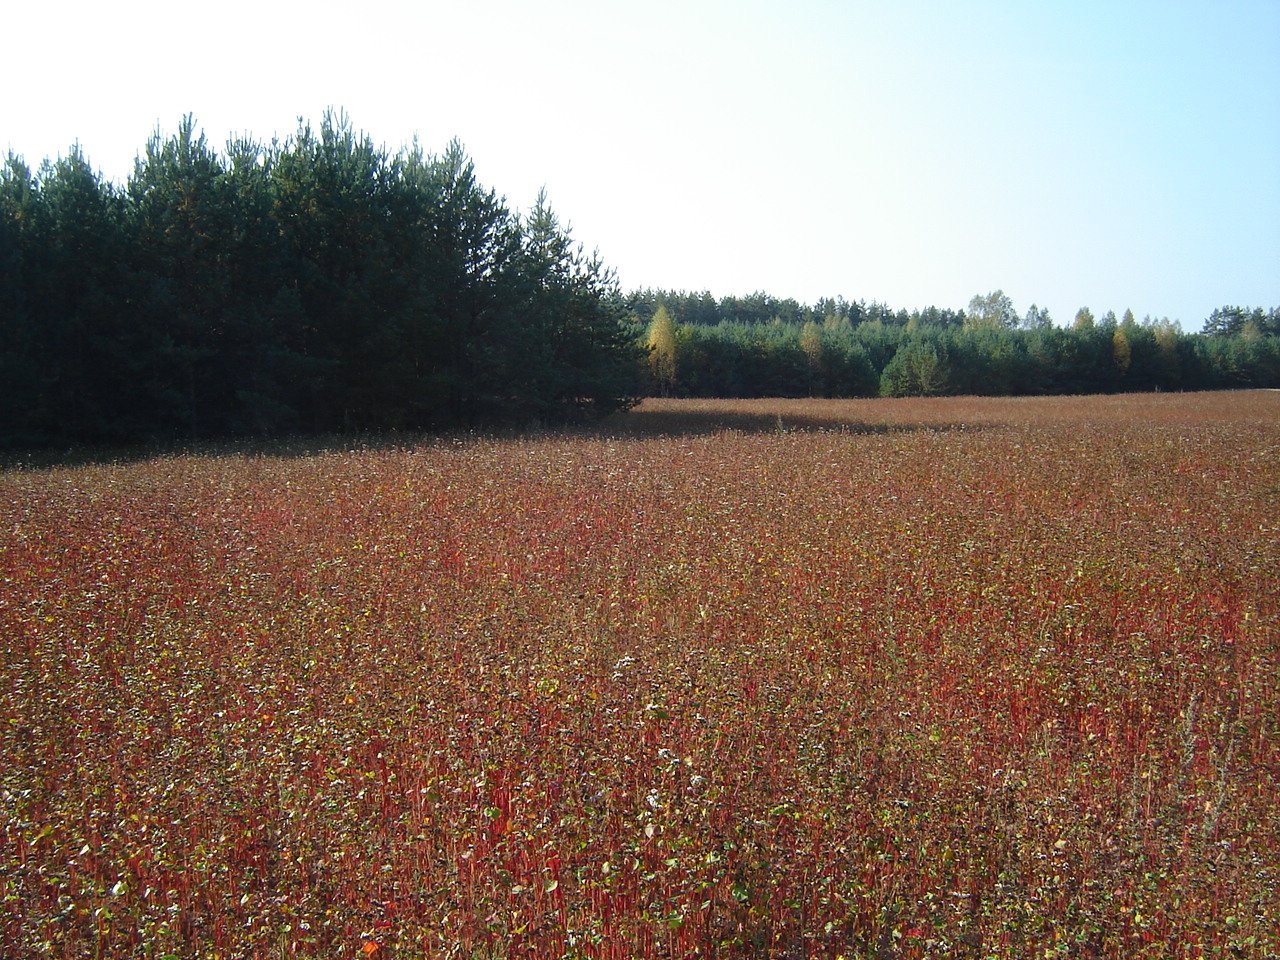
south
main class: Cropland
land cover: Other cereals
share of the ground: > 75 %
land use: Agriculture (excluding fallow land and kitchen gardens)
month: August
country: LT
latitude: 54.5796
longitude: 24.8872
